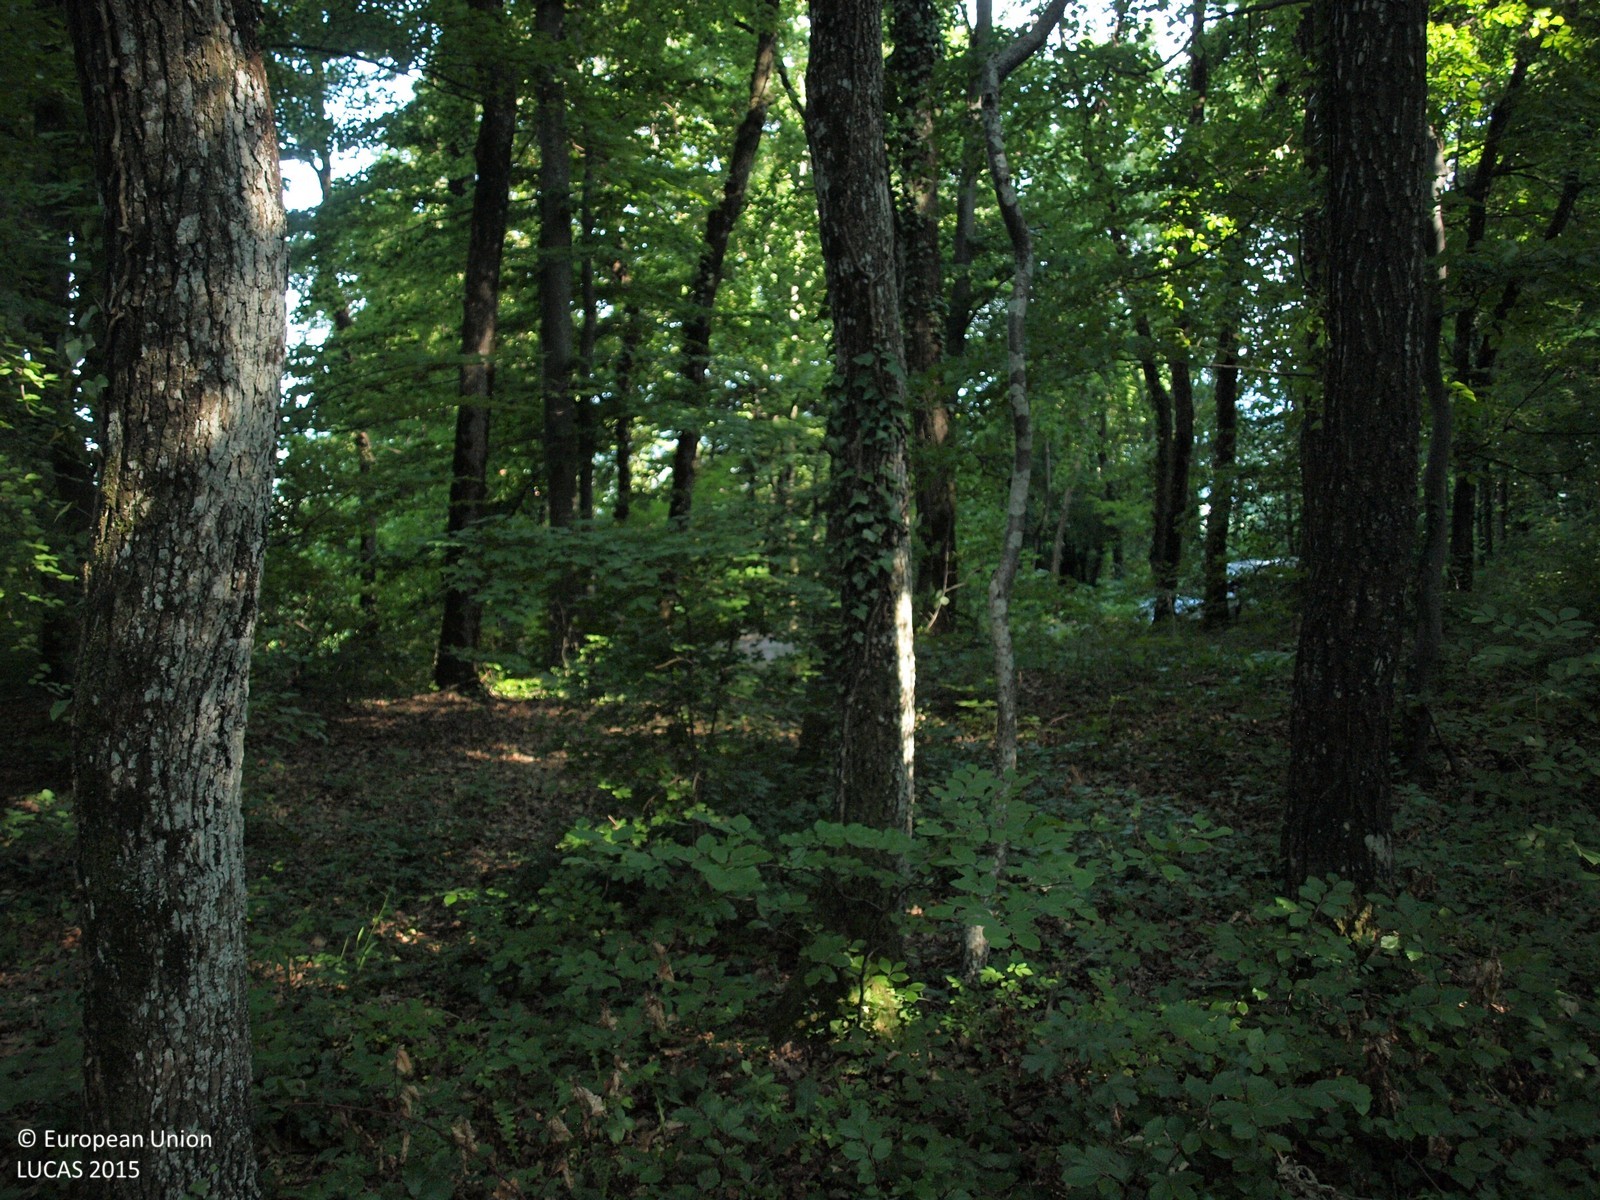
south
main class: Woodland
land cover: Broadleaved woodland
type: mesophytic deciduous forest
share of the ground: > 75 %
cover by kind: broadleaved forest trees 100 %
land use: Forestry
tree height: > 5 m
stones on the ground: < 10 %
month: July
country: HR
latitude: 46.1650
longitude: 15.9952
